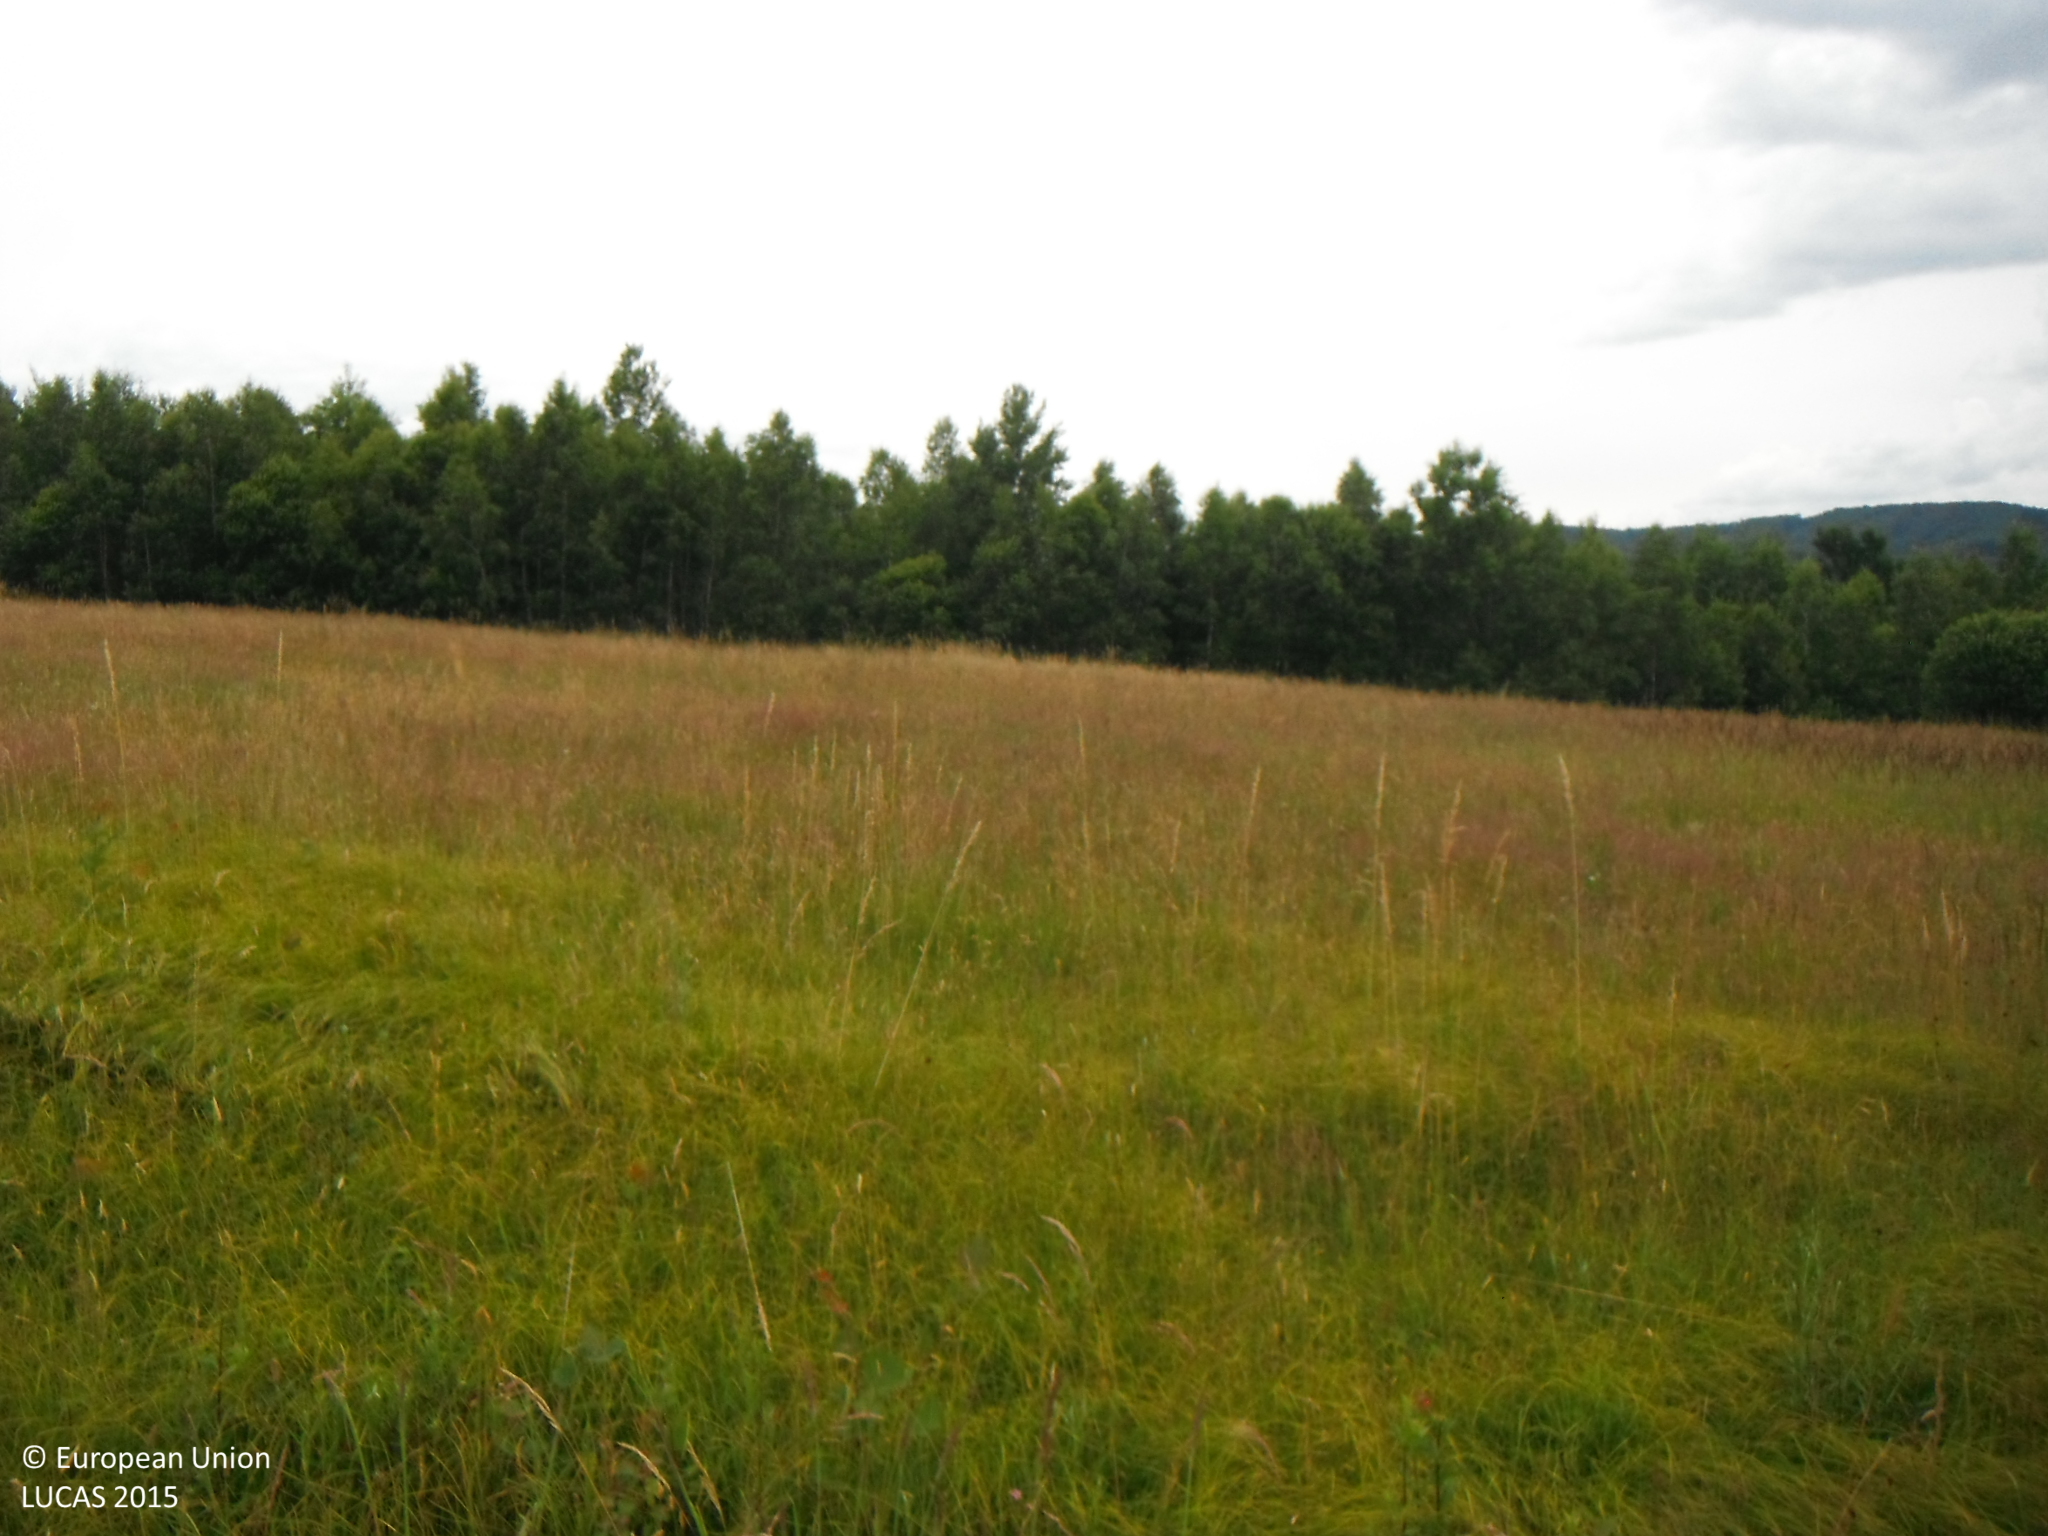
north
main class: Grassland
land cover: Grassland without tree/shrub cover
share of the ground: > 75 %
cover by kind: herbaceous plants 100 %
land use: Agriculture (excluding fallow land and kitchen gardens)
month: June
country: SK
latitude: 49.0034
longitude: 21.9891
